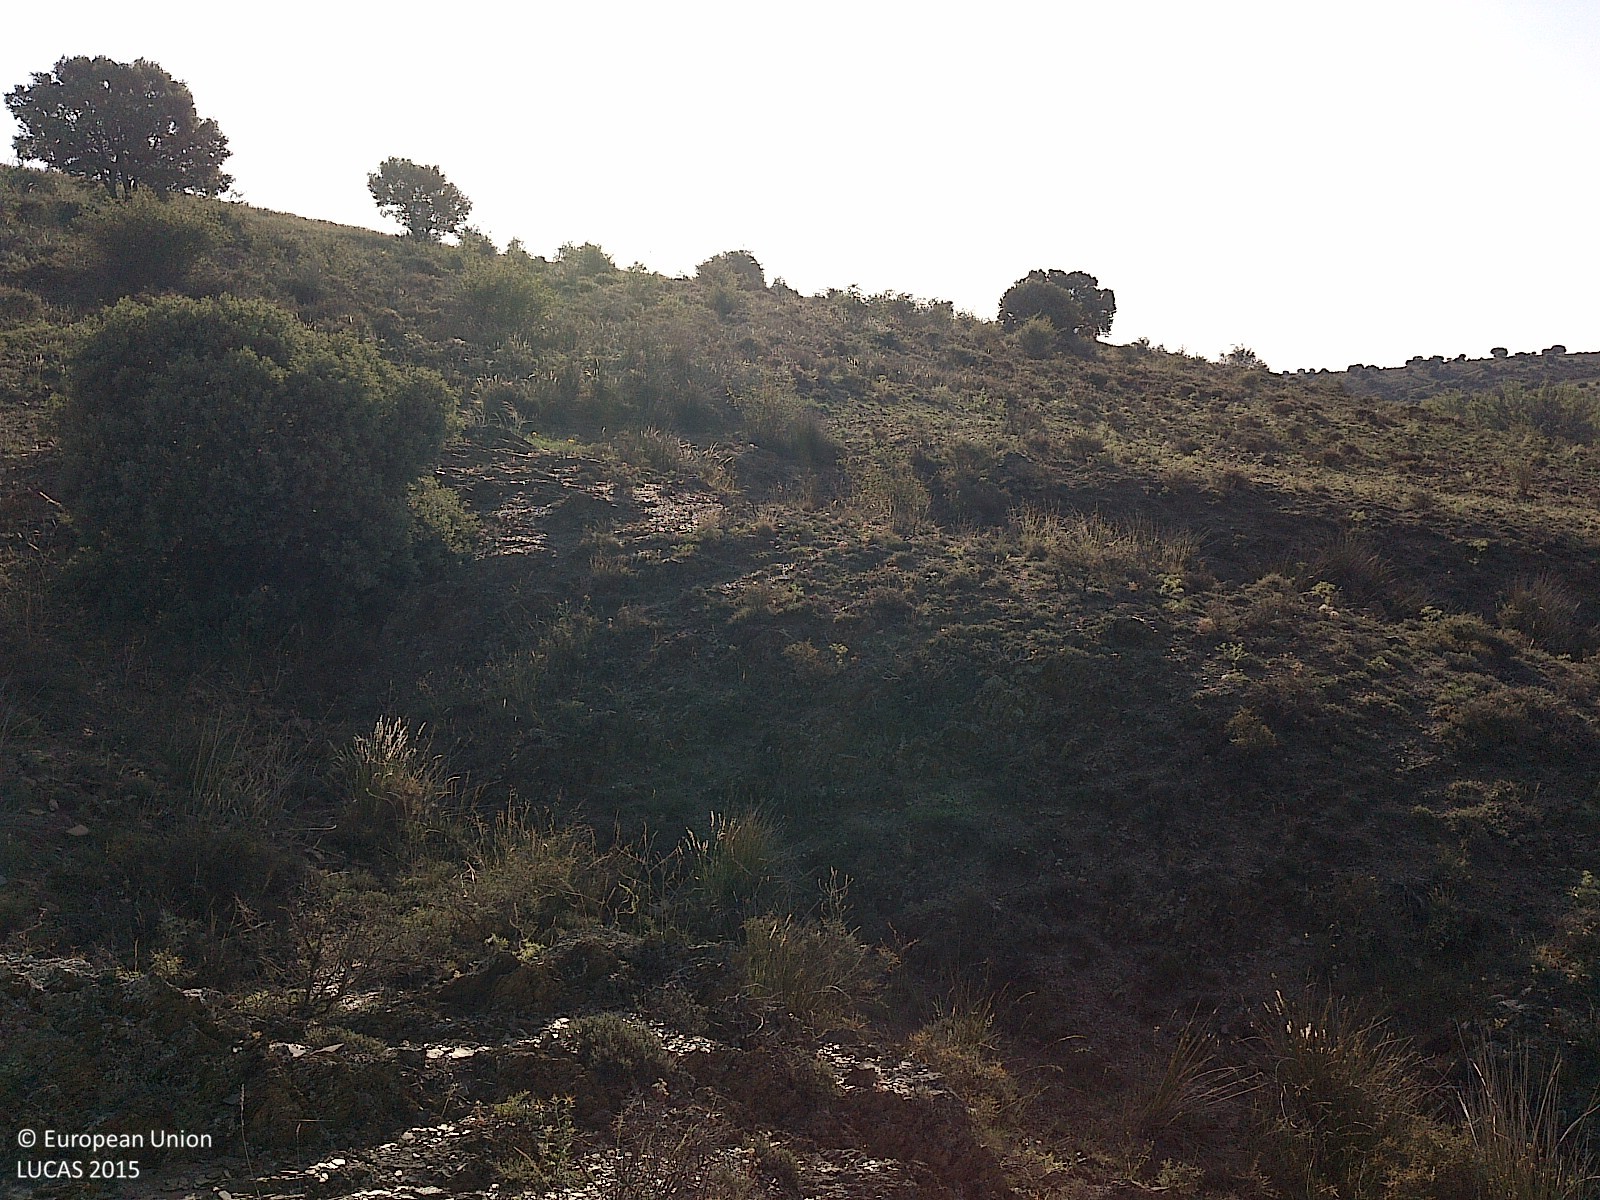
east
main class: Shrubland
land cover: Shrubland without tree cover
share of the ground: 25 - 50 %
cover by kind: consolidated bare surface 50 %, shrubs 25 %, herbaceous plants 10 %, unconsolidated bare surface 10 %, lichens and mosses 5 %
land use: Agriculture (excluding fallow land and kitchen gardens)
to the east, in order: Shrubland without tree cover; Single bushes/trees; Shrubland without tree cover; Common wheat; Shrubland without tree cover
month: July
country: ES
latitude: 41.5003
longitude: -1.9977
